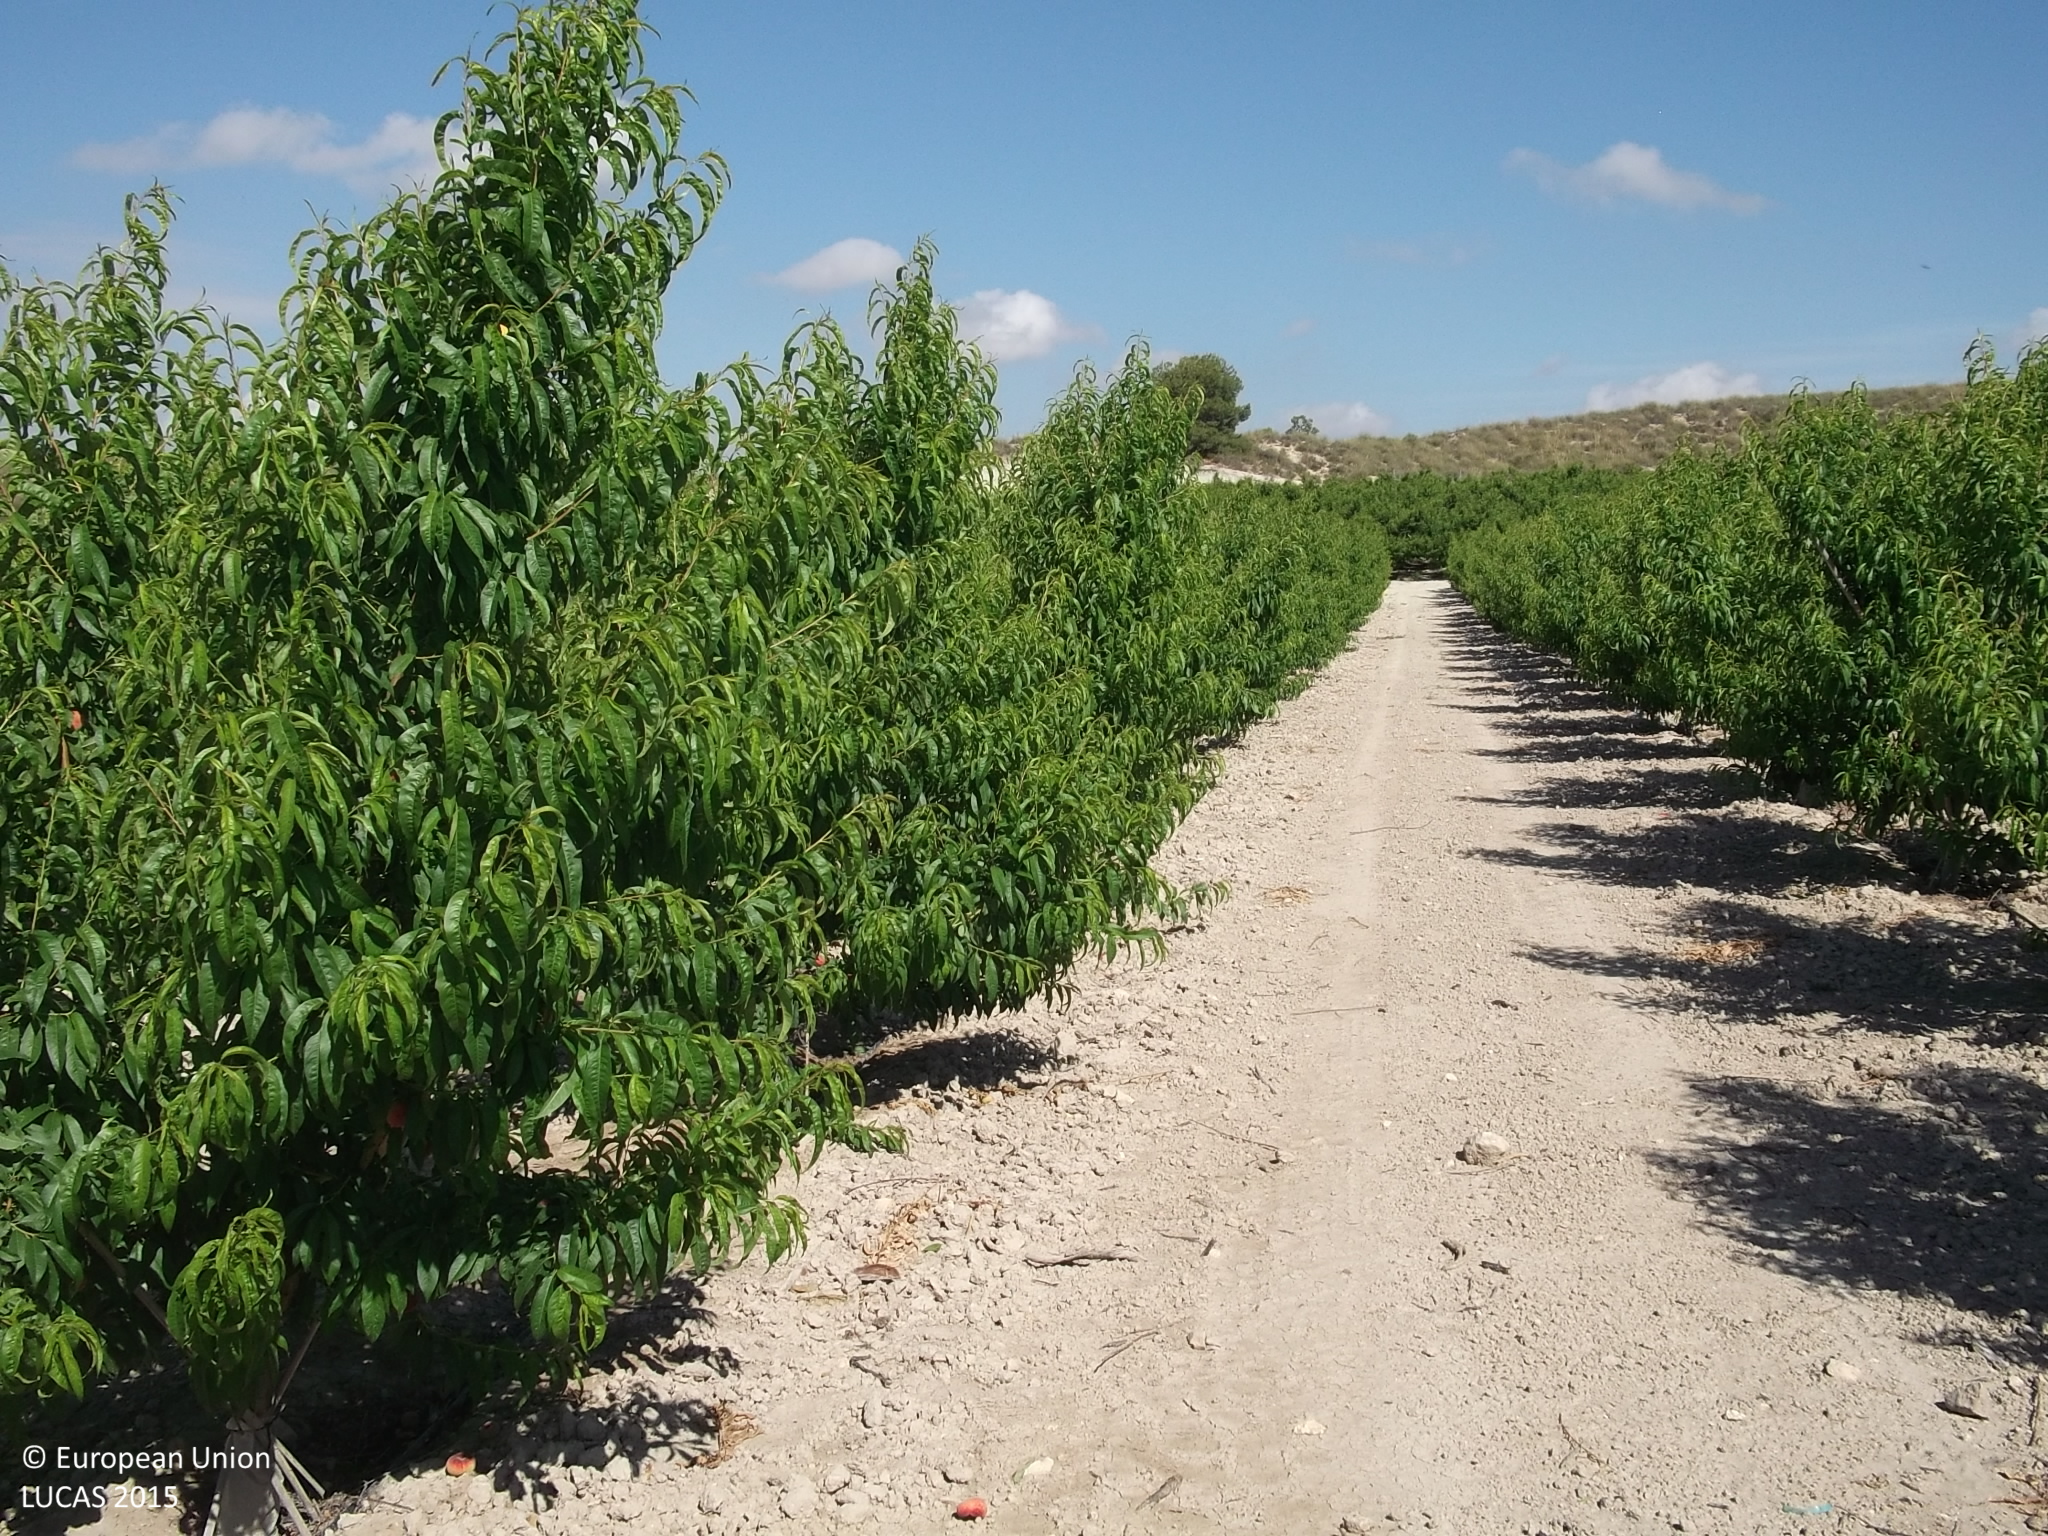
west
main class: Cropland
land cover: Other fruit trees and berries
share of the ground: 10 - 25 %
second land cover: Other bare soil
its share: > 75 %
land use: Agriculture (excluding fallow land and kitchen gardens)
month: May
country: ES
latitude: 38.3198
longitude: -1.4158
